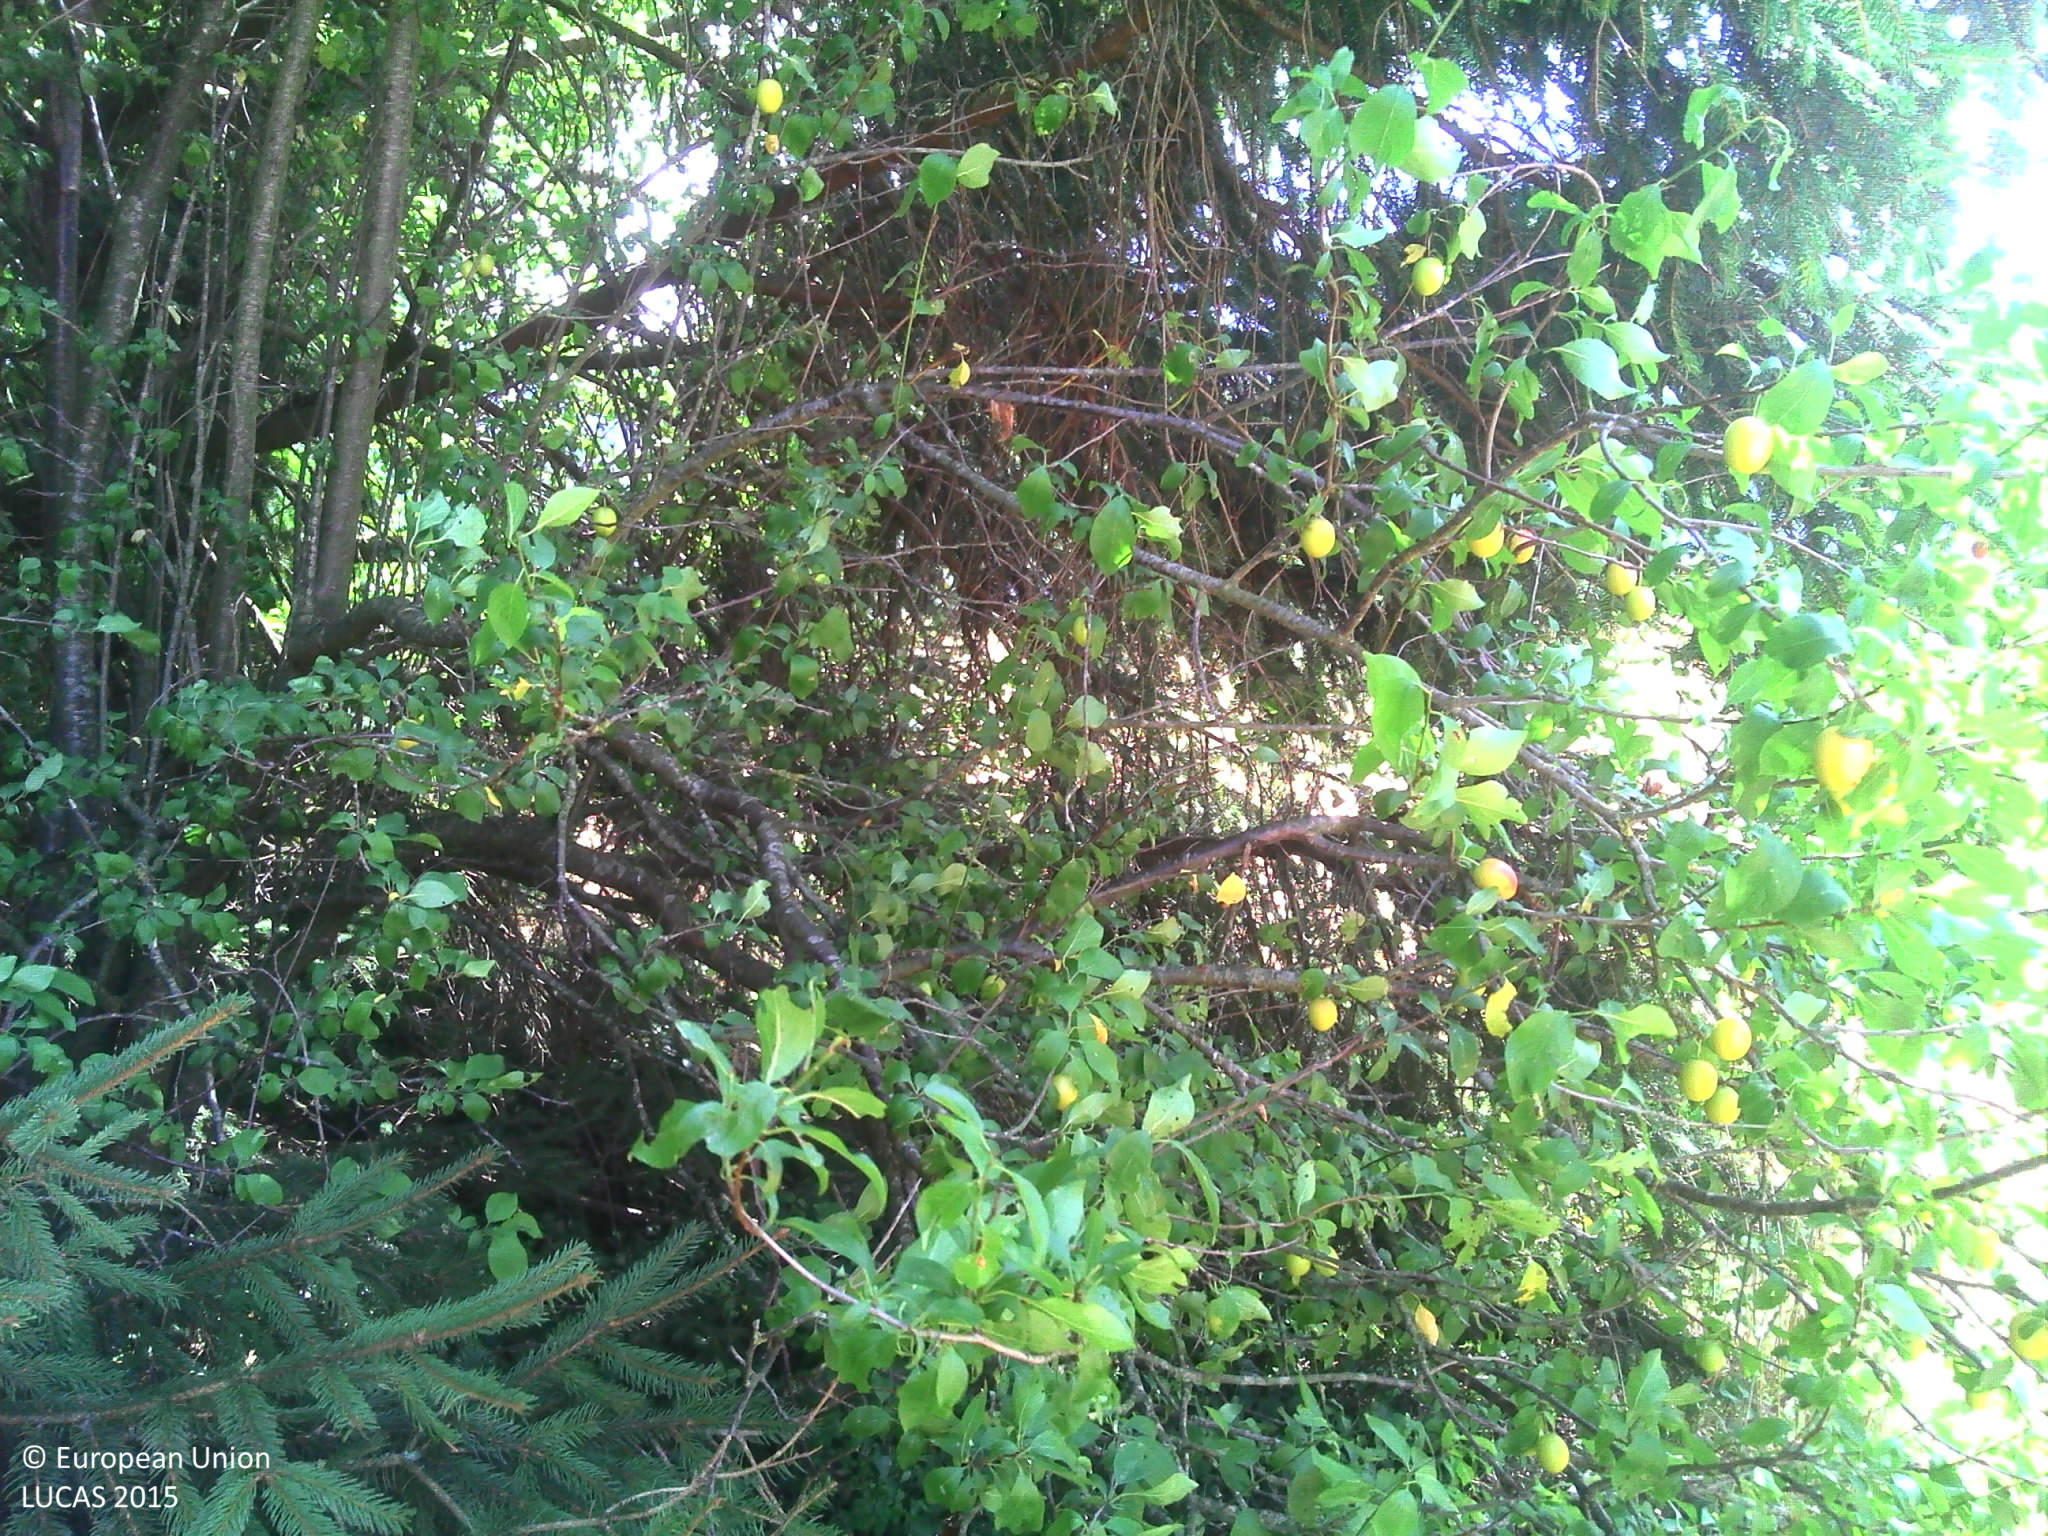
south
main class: Cropland
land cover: Rye
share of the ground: < 10 %
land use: Agriculture (excluding fallow land and kitchen gardens)
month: July
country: FR
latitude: 45.7801
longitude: 6.2357
